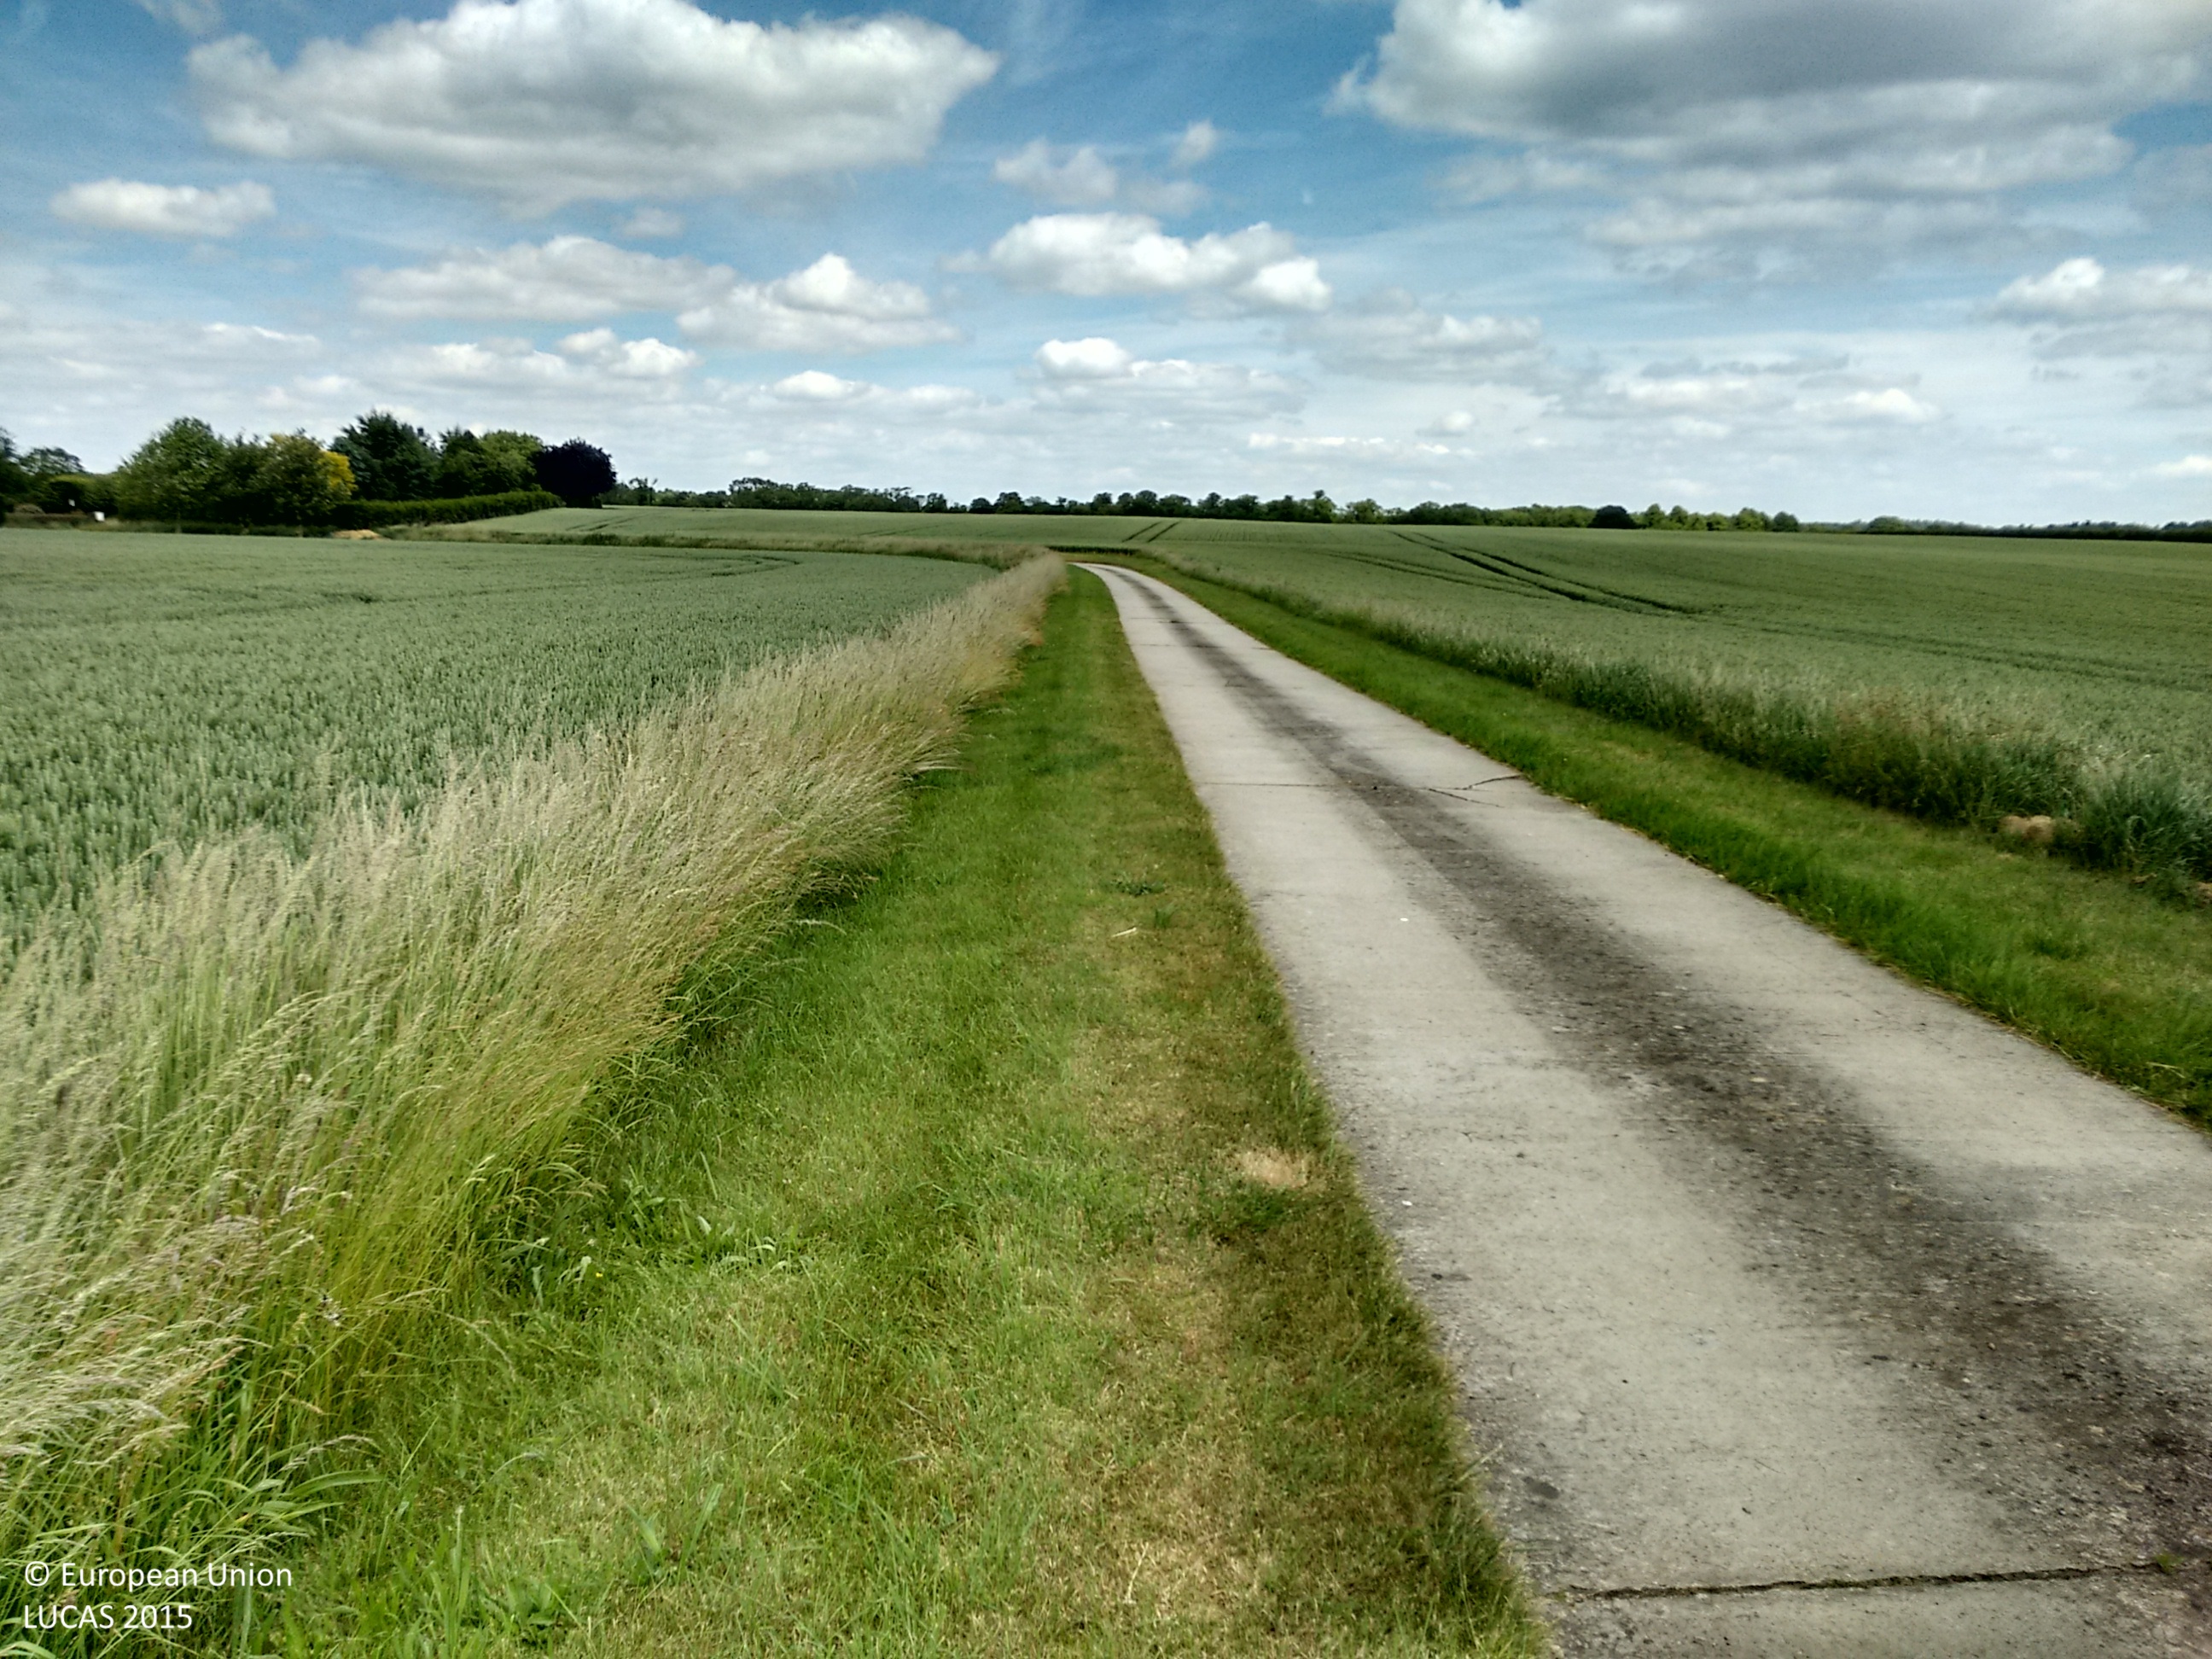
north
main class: Cropland
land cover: Common wheat
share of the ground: > 75 %
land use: Agriculture (excluding fallow land and kitchen gardens)
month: June
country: GB
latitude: 51.6488
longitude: -1.5417
